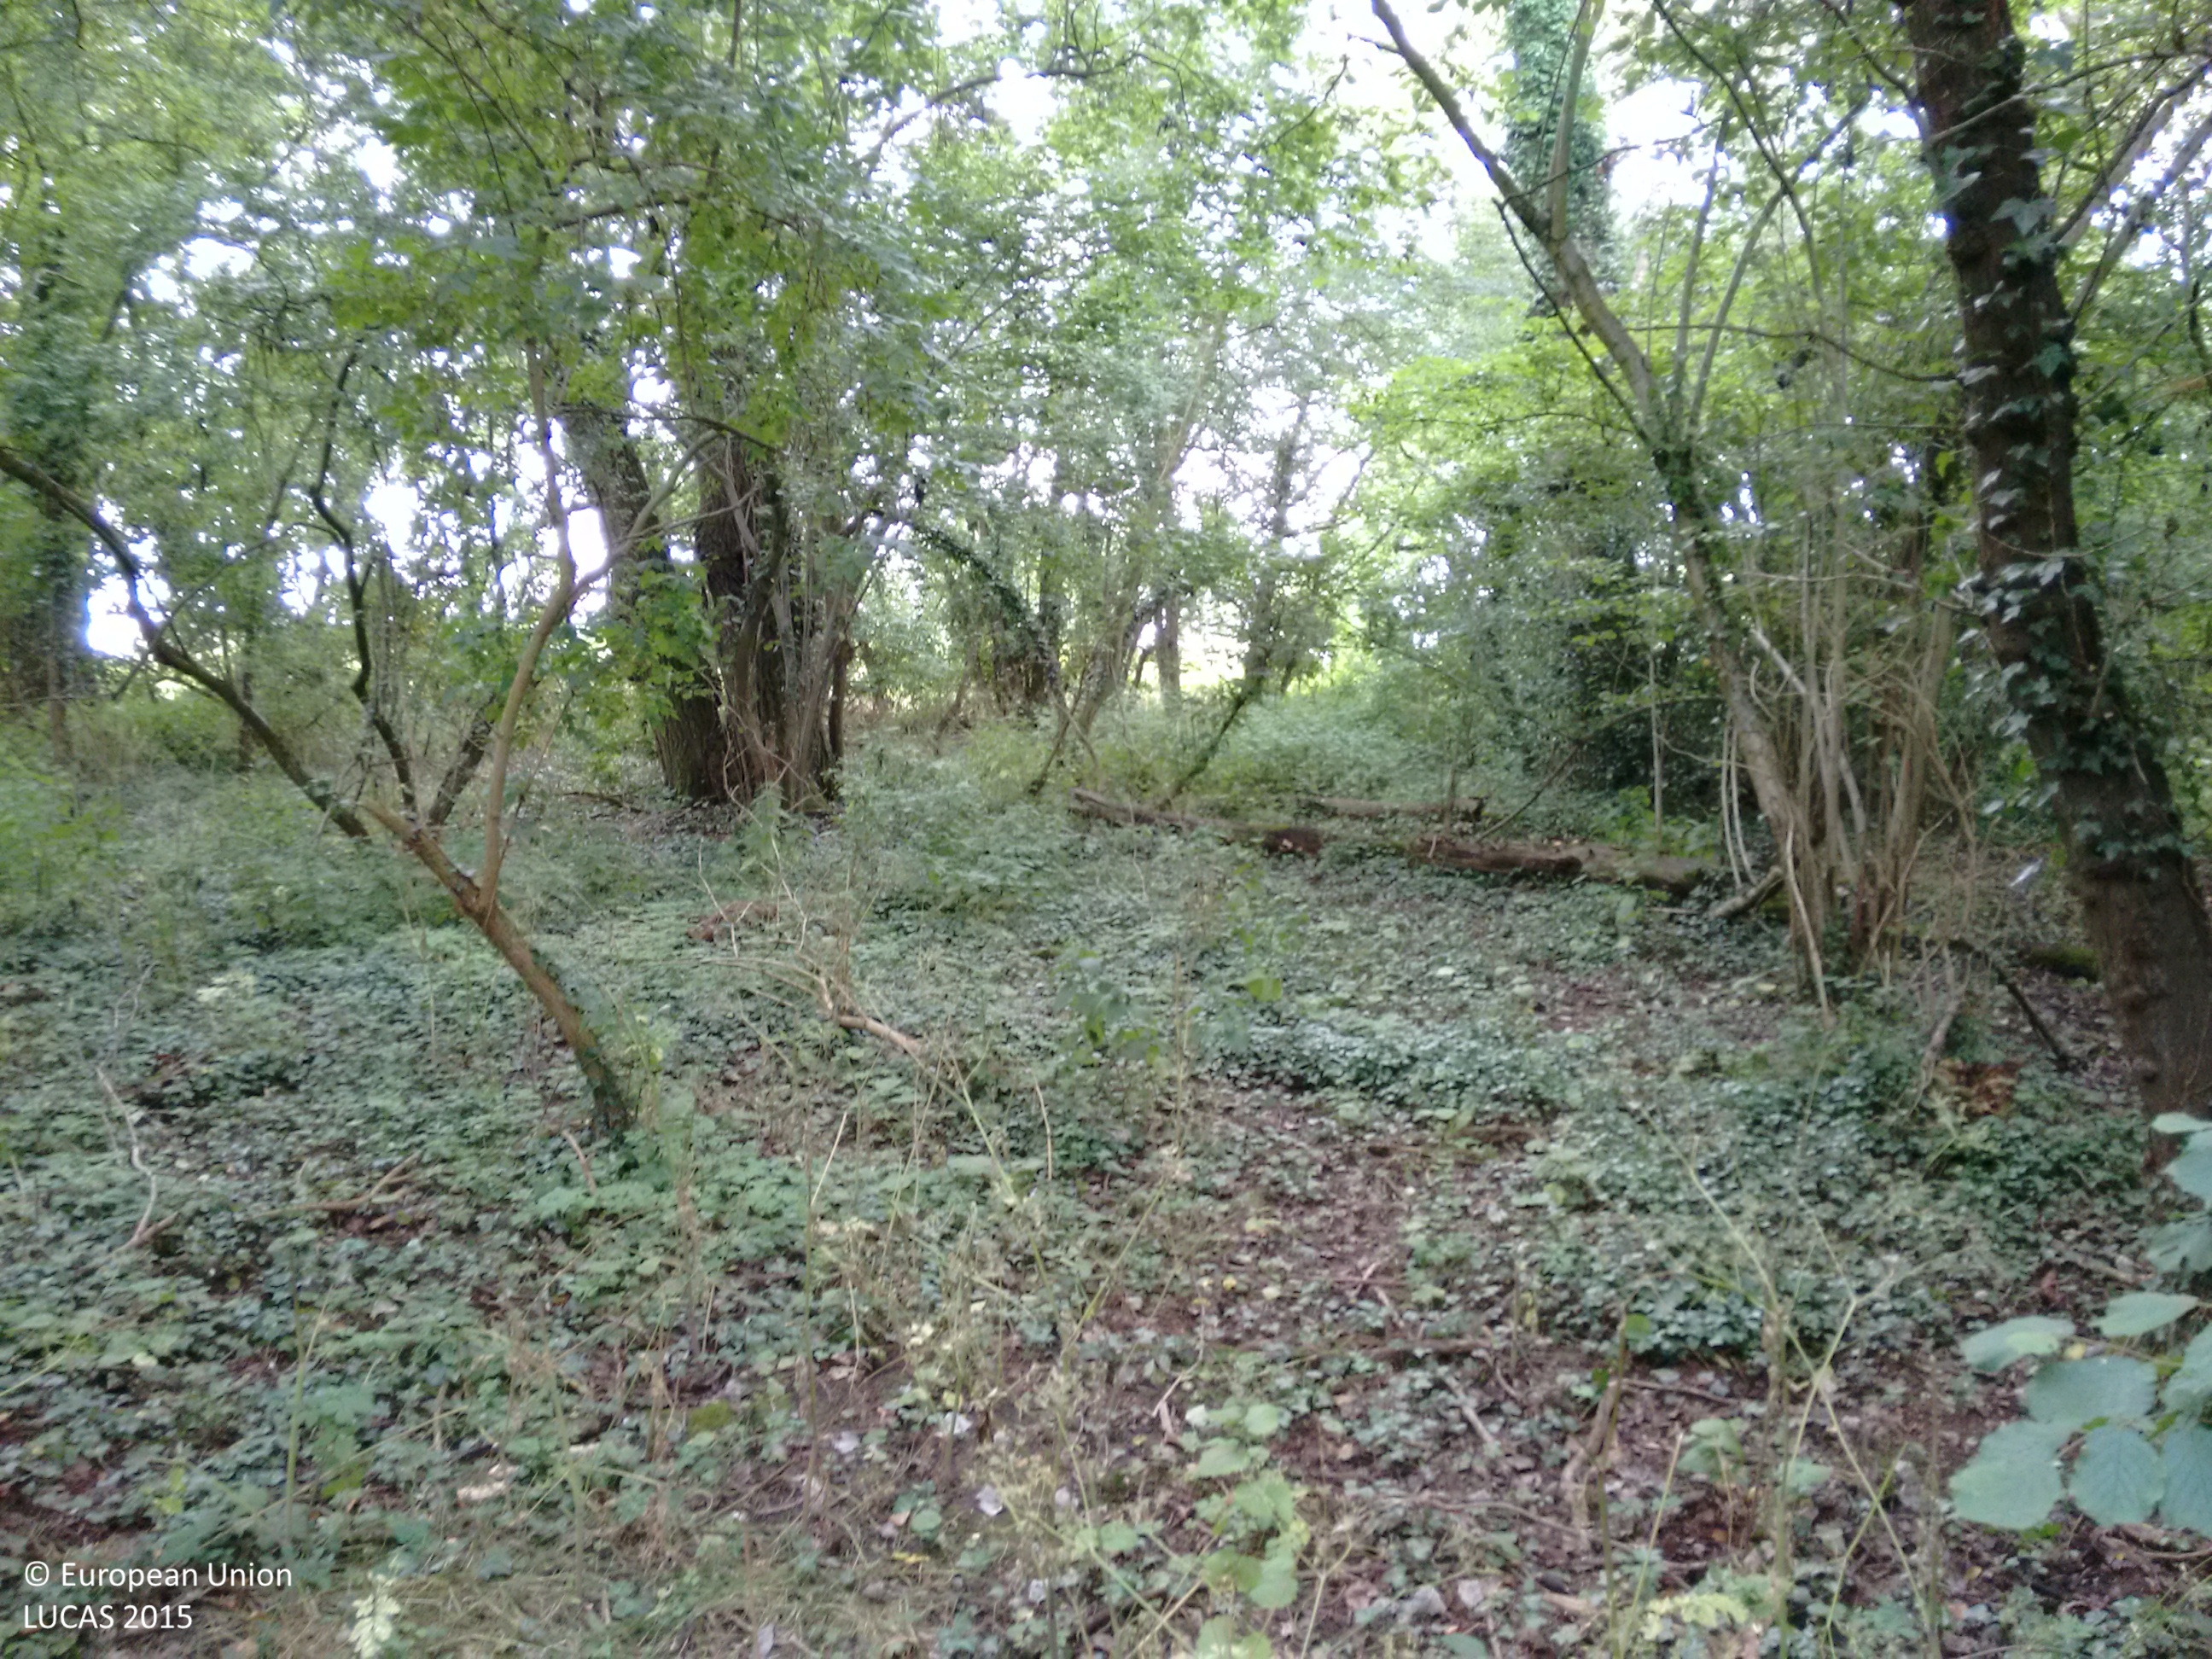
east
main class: Woodland
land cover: Broadleaved woodland
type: mesophytic deciduous forest
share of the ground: > 75 %
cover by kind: broadleaved forest trees 90 %, herbaceous plants 10 %
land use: Semi-natural and natural areas not in use
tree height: > 5 m
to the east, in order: Broadleaved woodland; Grassland without tree/shrub cover; Rape and turnip rape
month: July
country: GB
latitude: 51.7317
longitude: -1.6218
